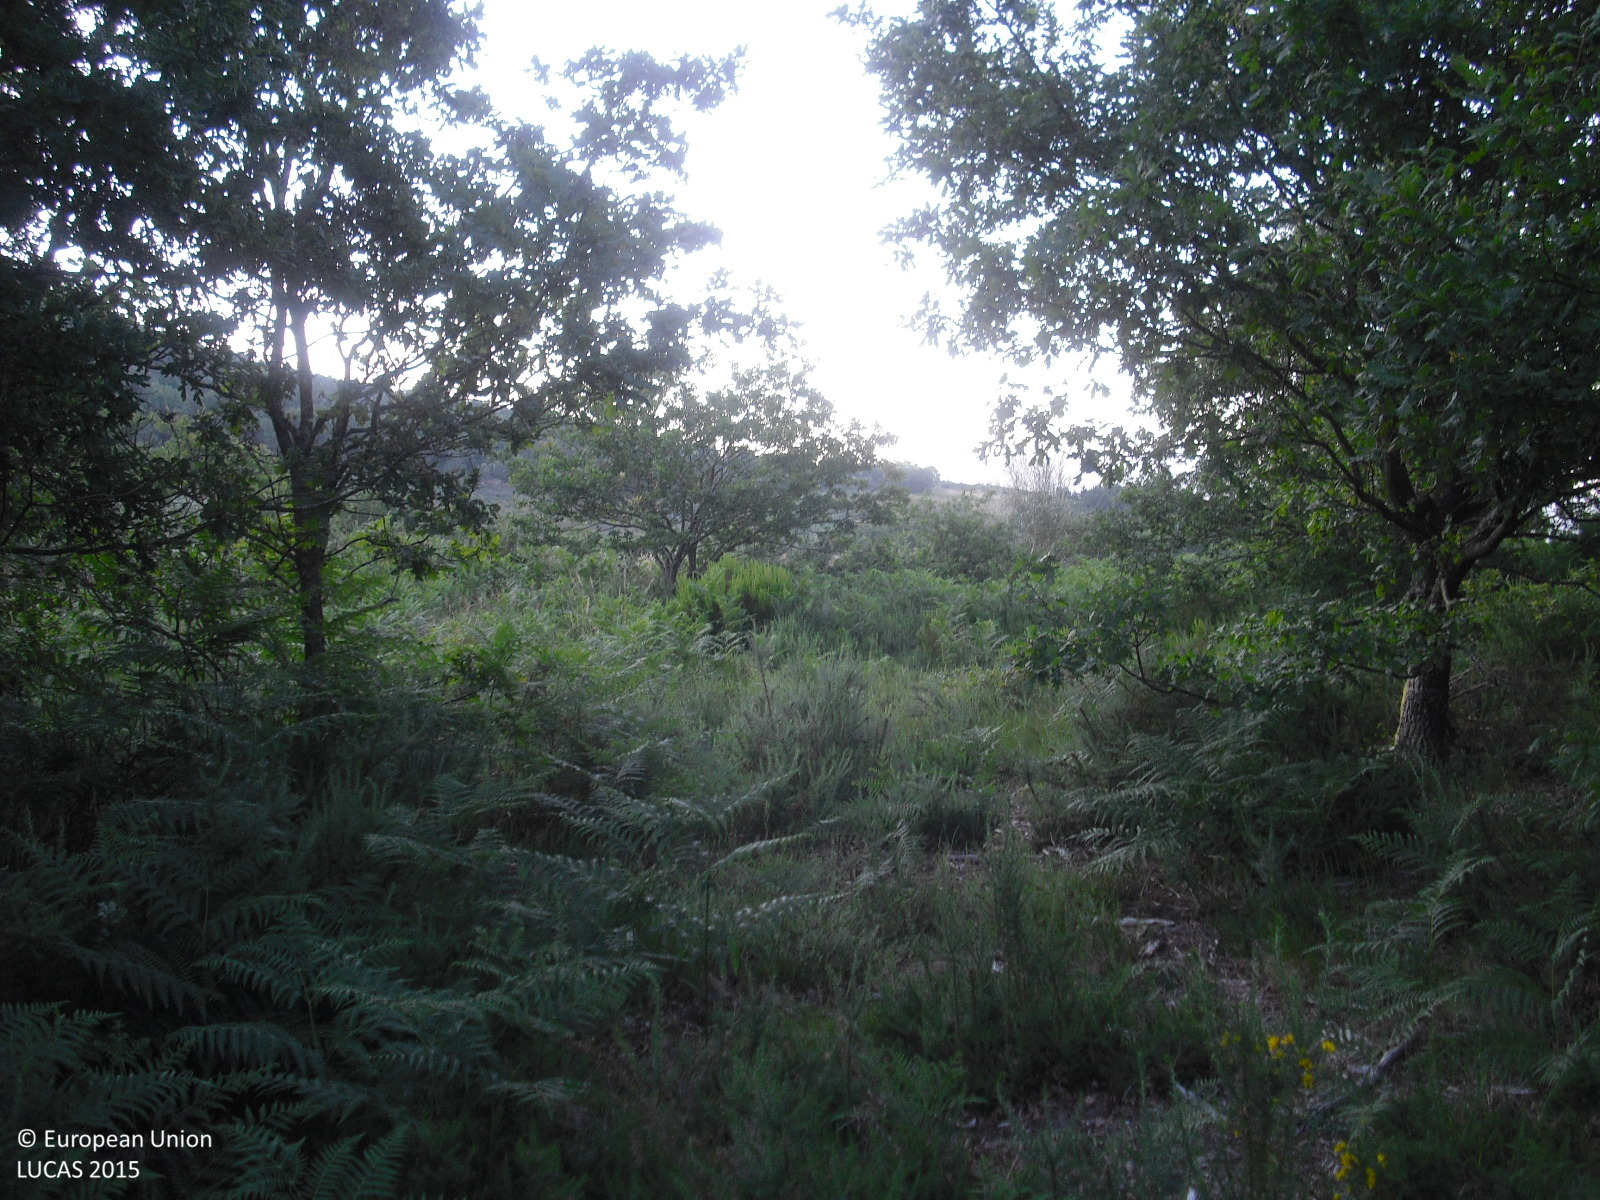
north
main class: Woodland
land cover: Broadleaved woodland
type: thermophilous deciduous forest
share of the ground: 50 - 75 %
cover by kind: broadleaved forest trees 60 %, shrubs 30 %, herbaceous plants 10 %
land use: Forestry
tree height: > 5 m
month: June
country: ES
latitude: 42.5571
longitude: -7.8999
